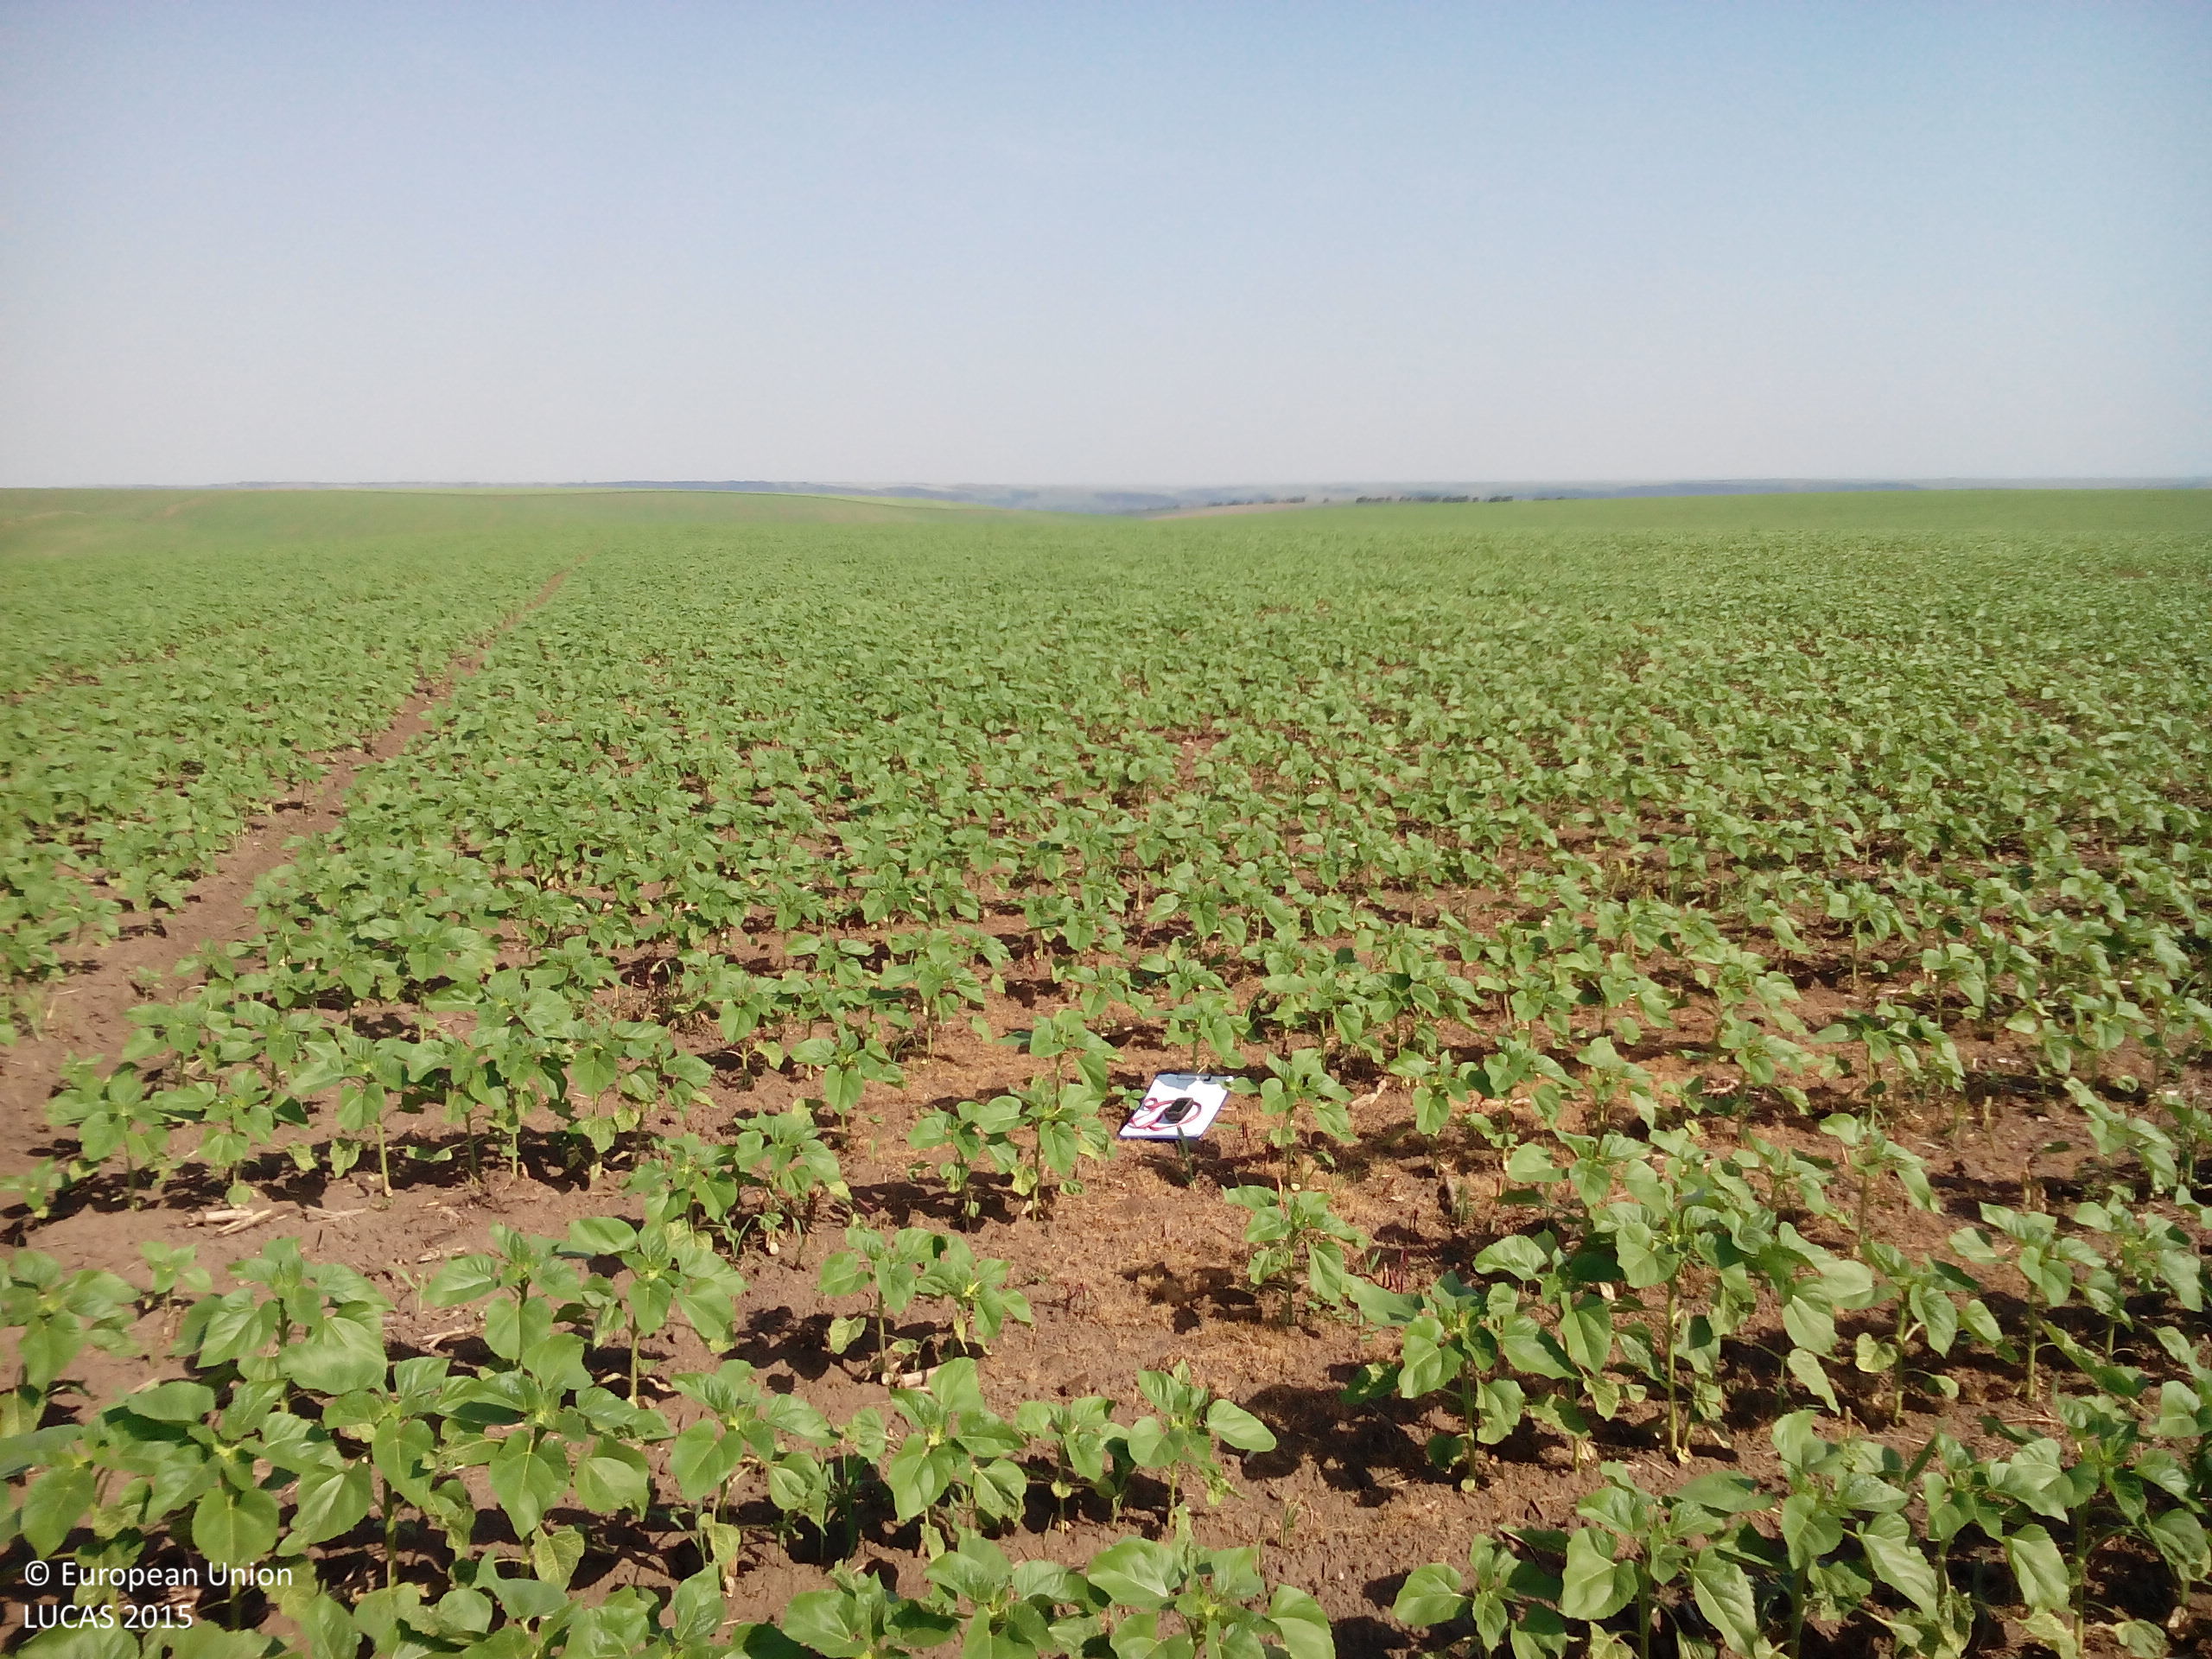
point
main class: Cropland
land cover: Sunflower
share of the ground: 50 - 75 %
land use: Agriculture (excluding fallow land and kitchen gardens)
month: May
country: BG
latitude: 43.6498
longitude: 24.2798
